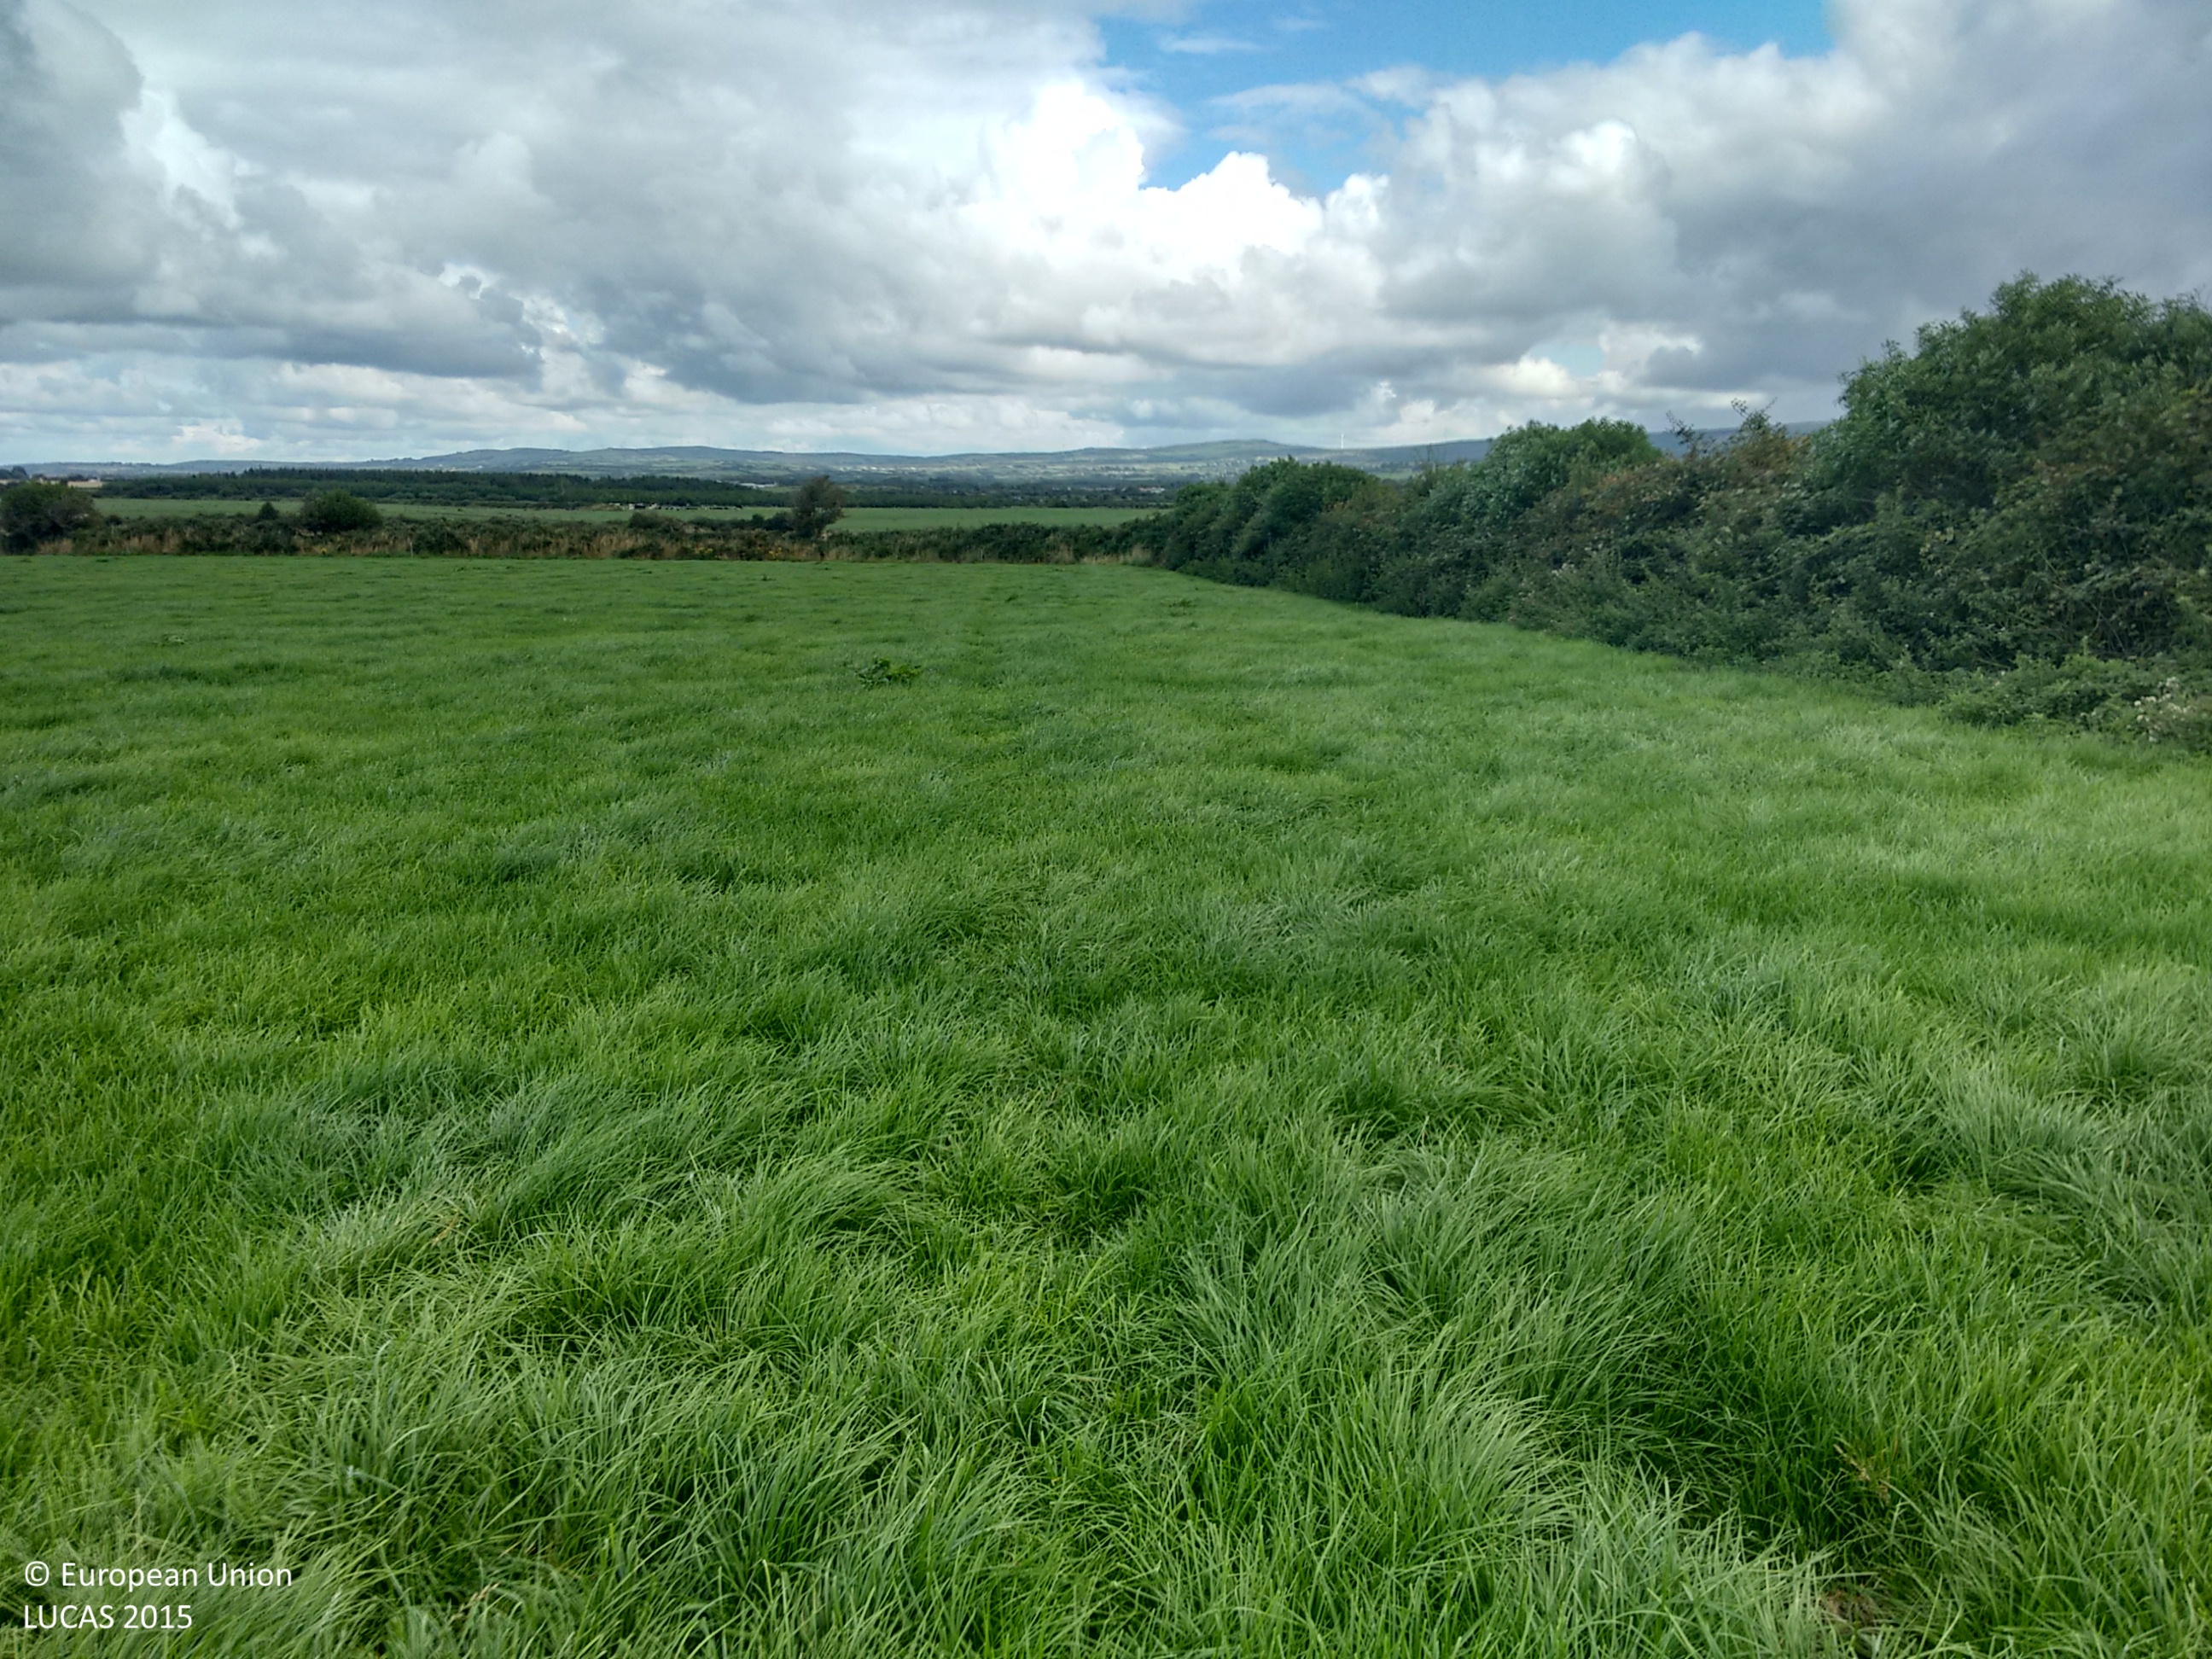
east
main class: Grassland
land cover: Grassland without tree/shrub cover
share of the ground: > 75 %
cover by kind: herbaceous plants 95 %, shrubs 5 %
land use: Agriculture (excluding fallow land and kitchen gardens)
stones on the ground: < 10 %
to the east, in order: Grassland without tree/shrub cover; Fences; Abandoned hedges; Grassland without tree/shrub cover; Fences; Abandoned hedges; Grassland without tree/shrub cover
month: September
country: IE
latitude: 52.3482
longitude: -9.7230
